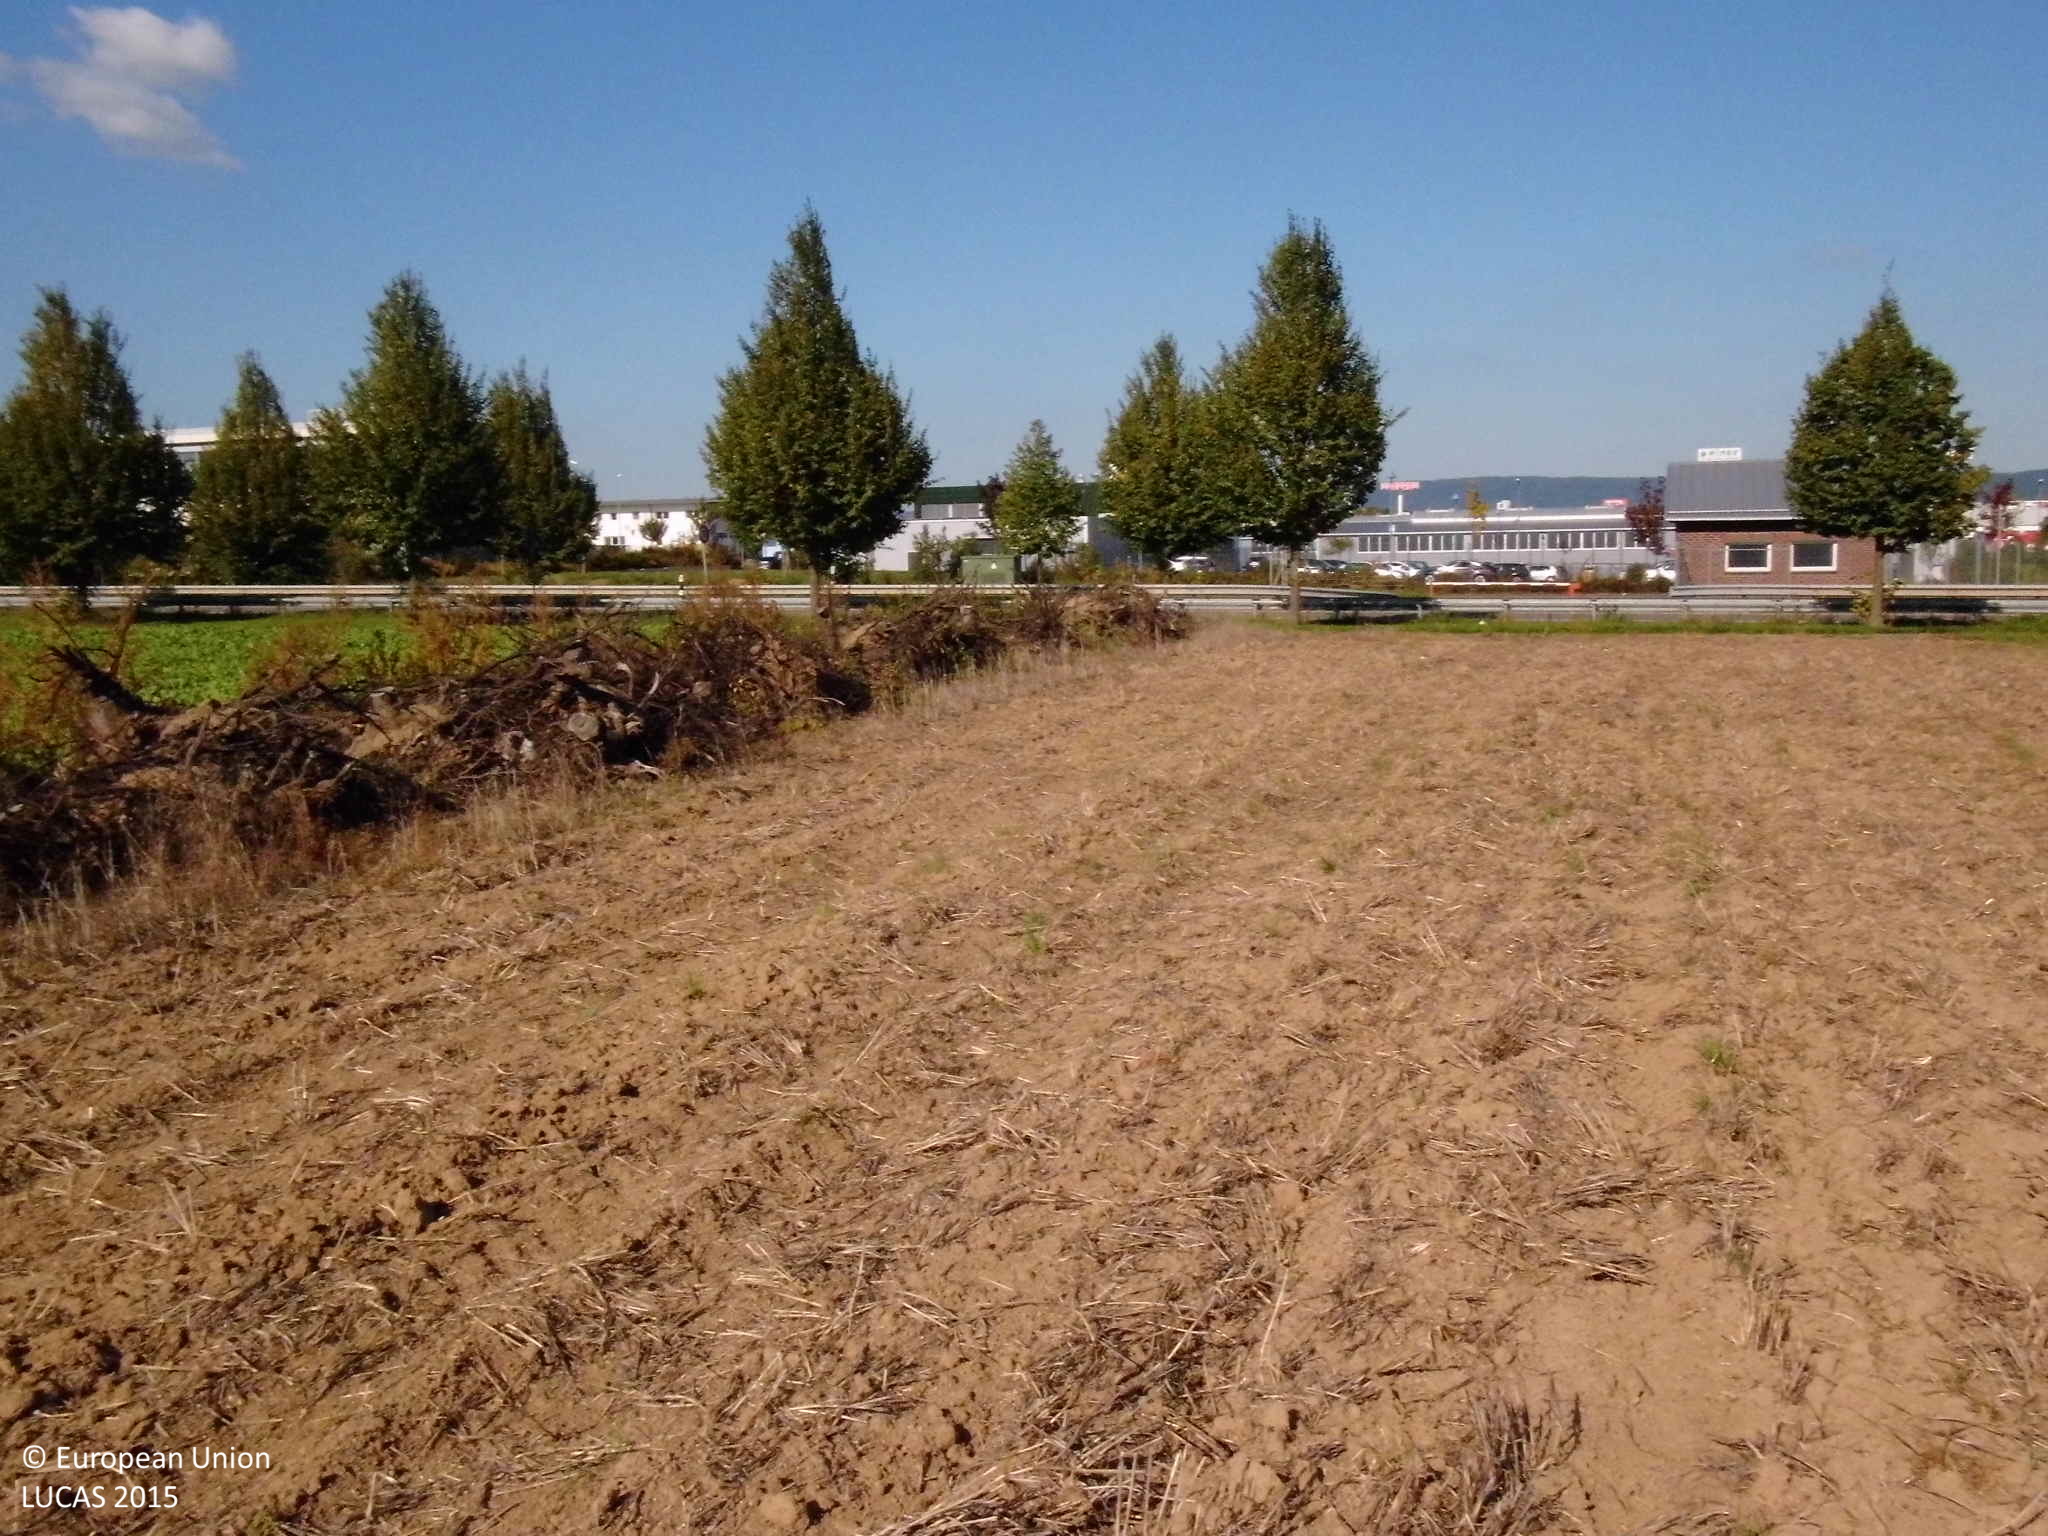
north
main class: Artificial land
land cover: Other artificial areas
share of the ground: < 10 %
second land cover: Common wheat
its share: < 10 %
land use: Electricity, gas and thermal power distribution
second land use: Agriculture (excluding fallow land and kitchen gardens)
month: September
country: DE
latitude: 50.3910
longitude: 7.5106
